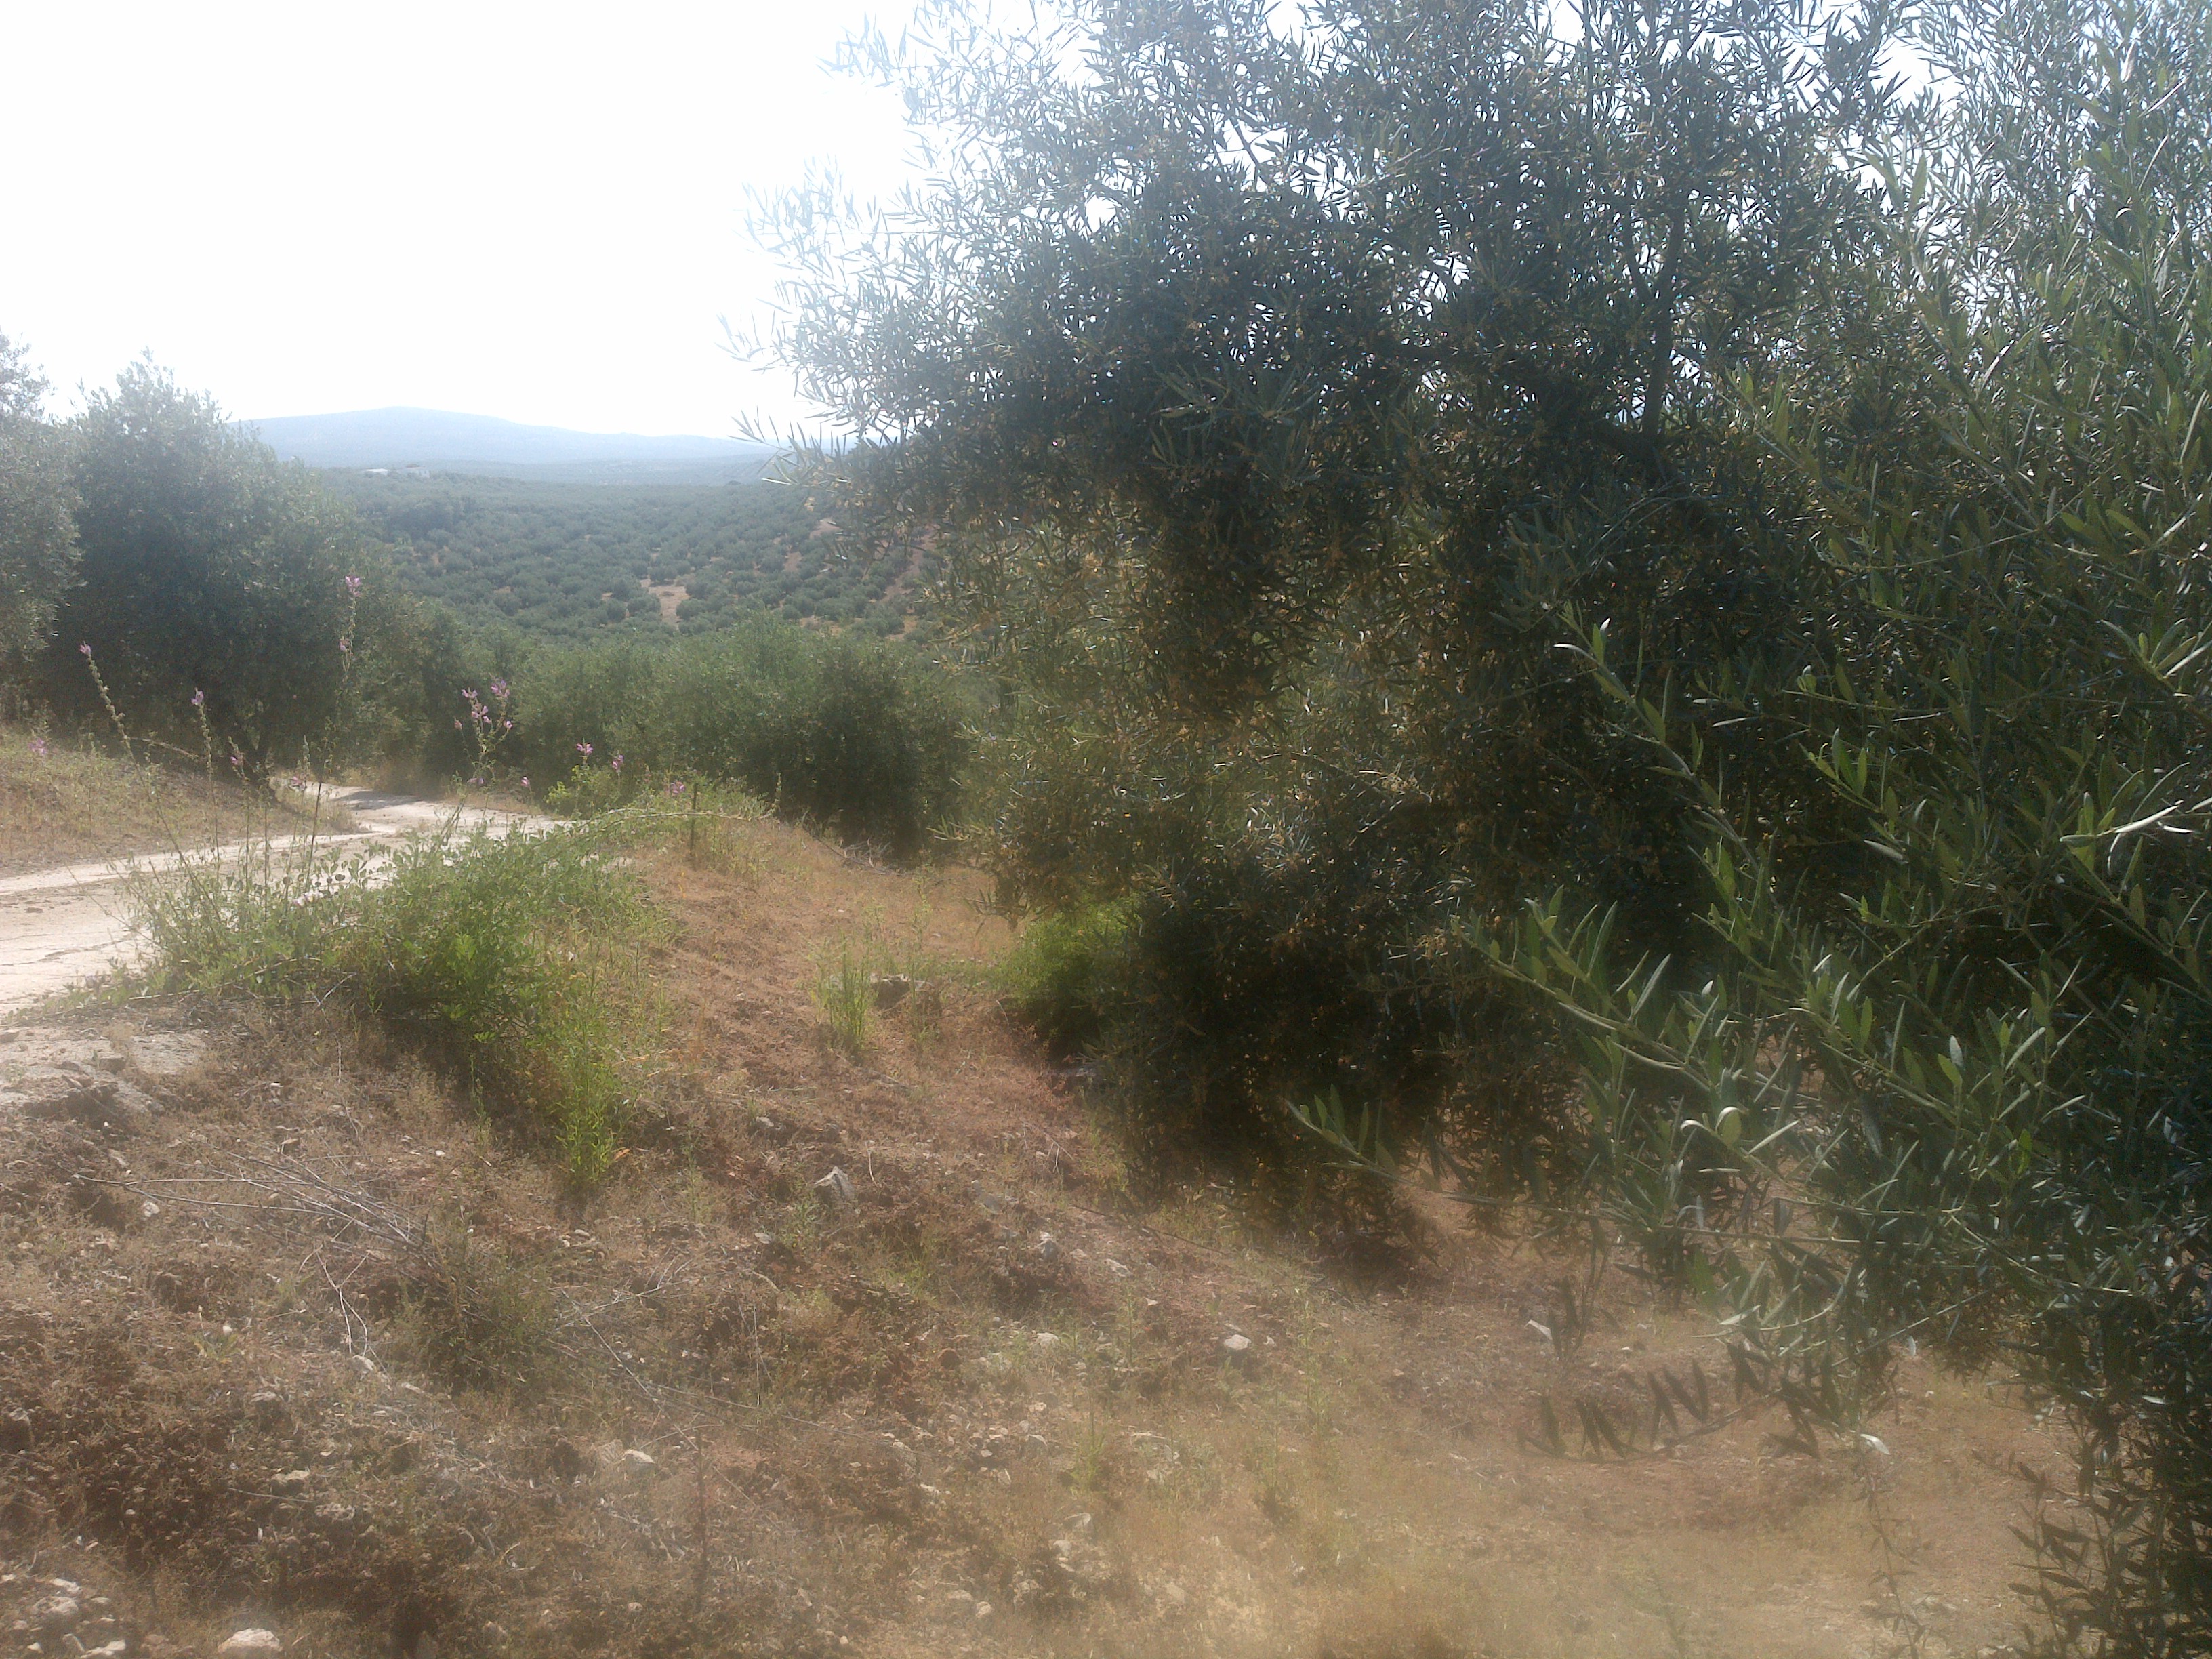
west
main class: Cropland
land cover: Olive groves
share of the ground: 25 - 50 %
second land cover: Spontaneously vegetated surfaces
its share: 10 - 25 %
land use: Agriculture (excluding fallow land and kitchen gardens)
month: May
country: ES
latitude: 37.4519
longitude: -4.4154
